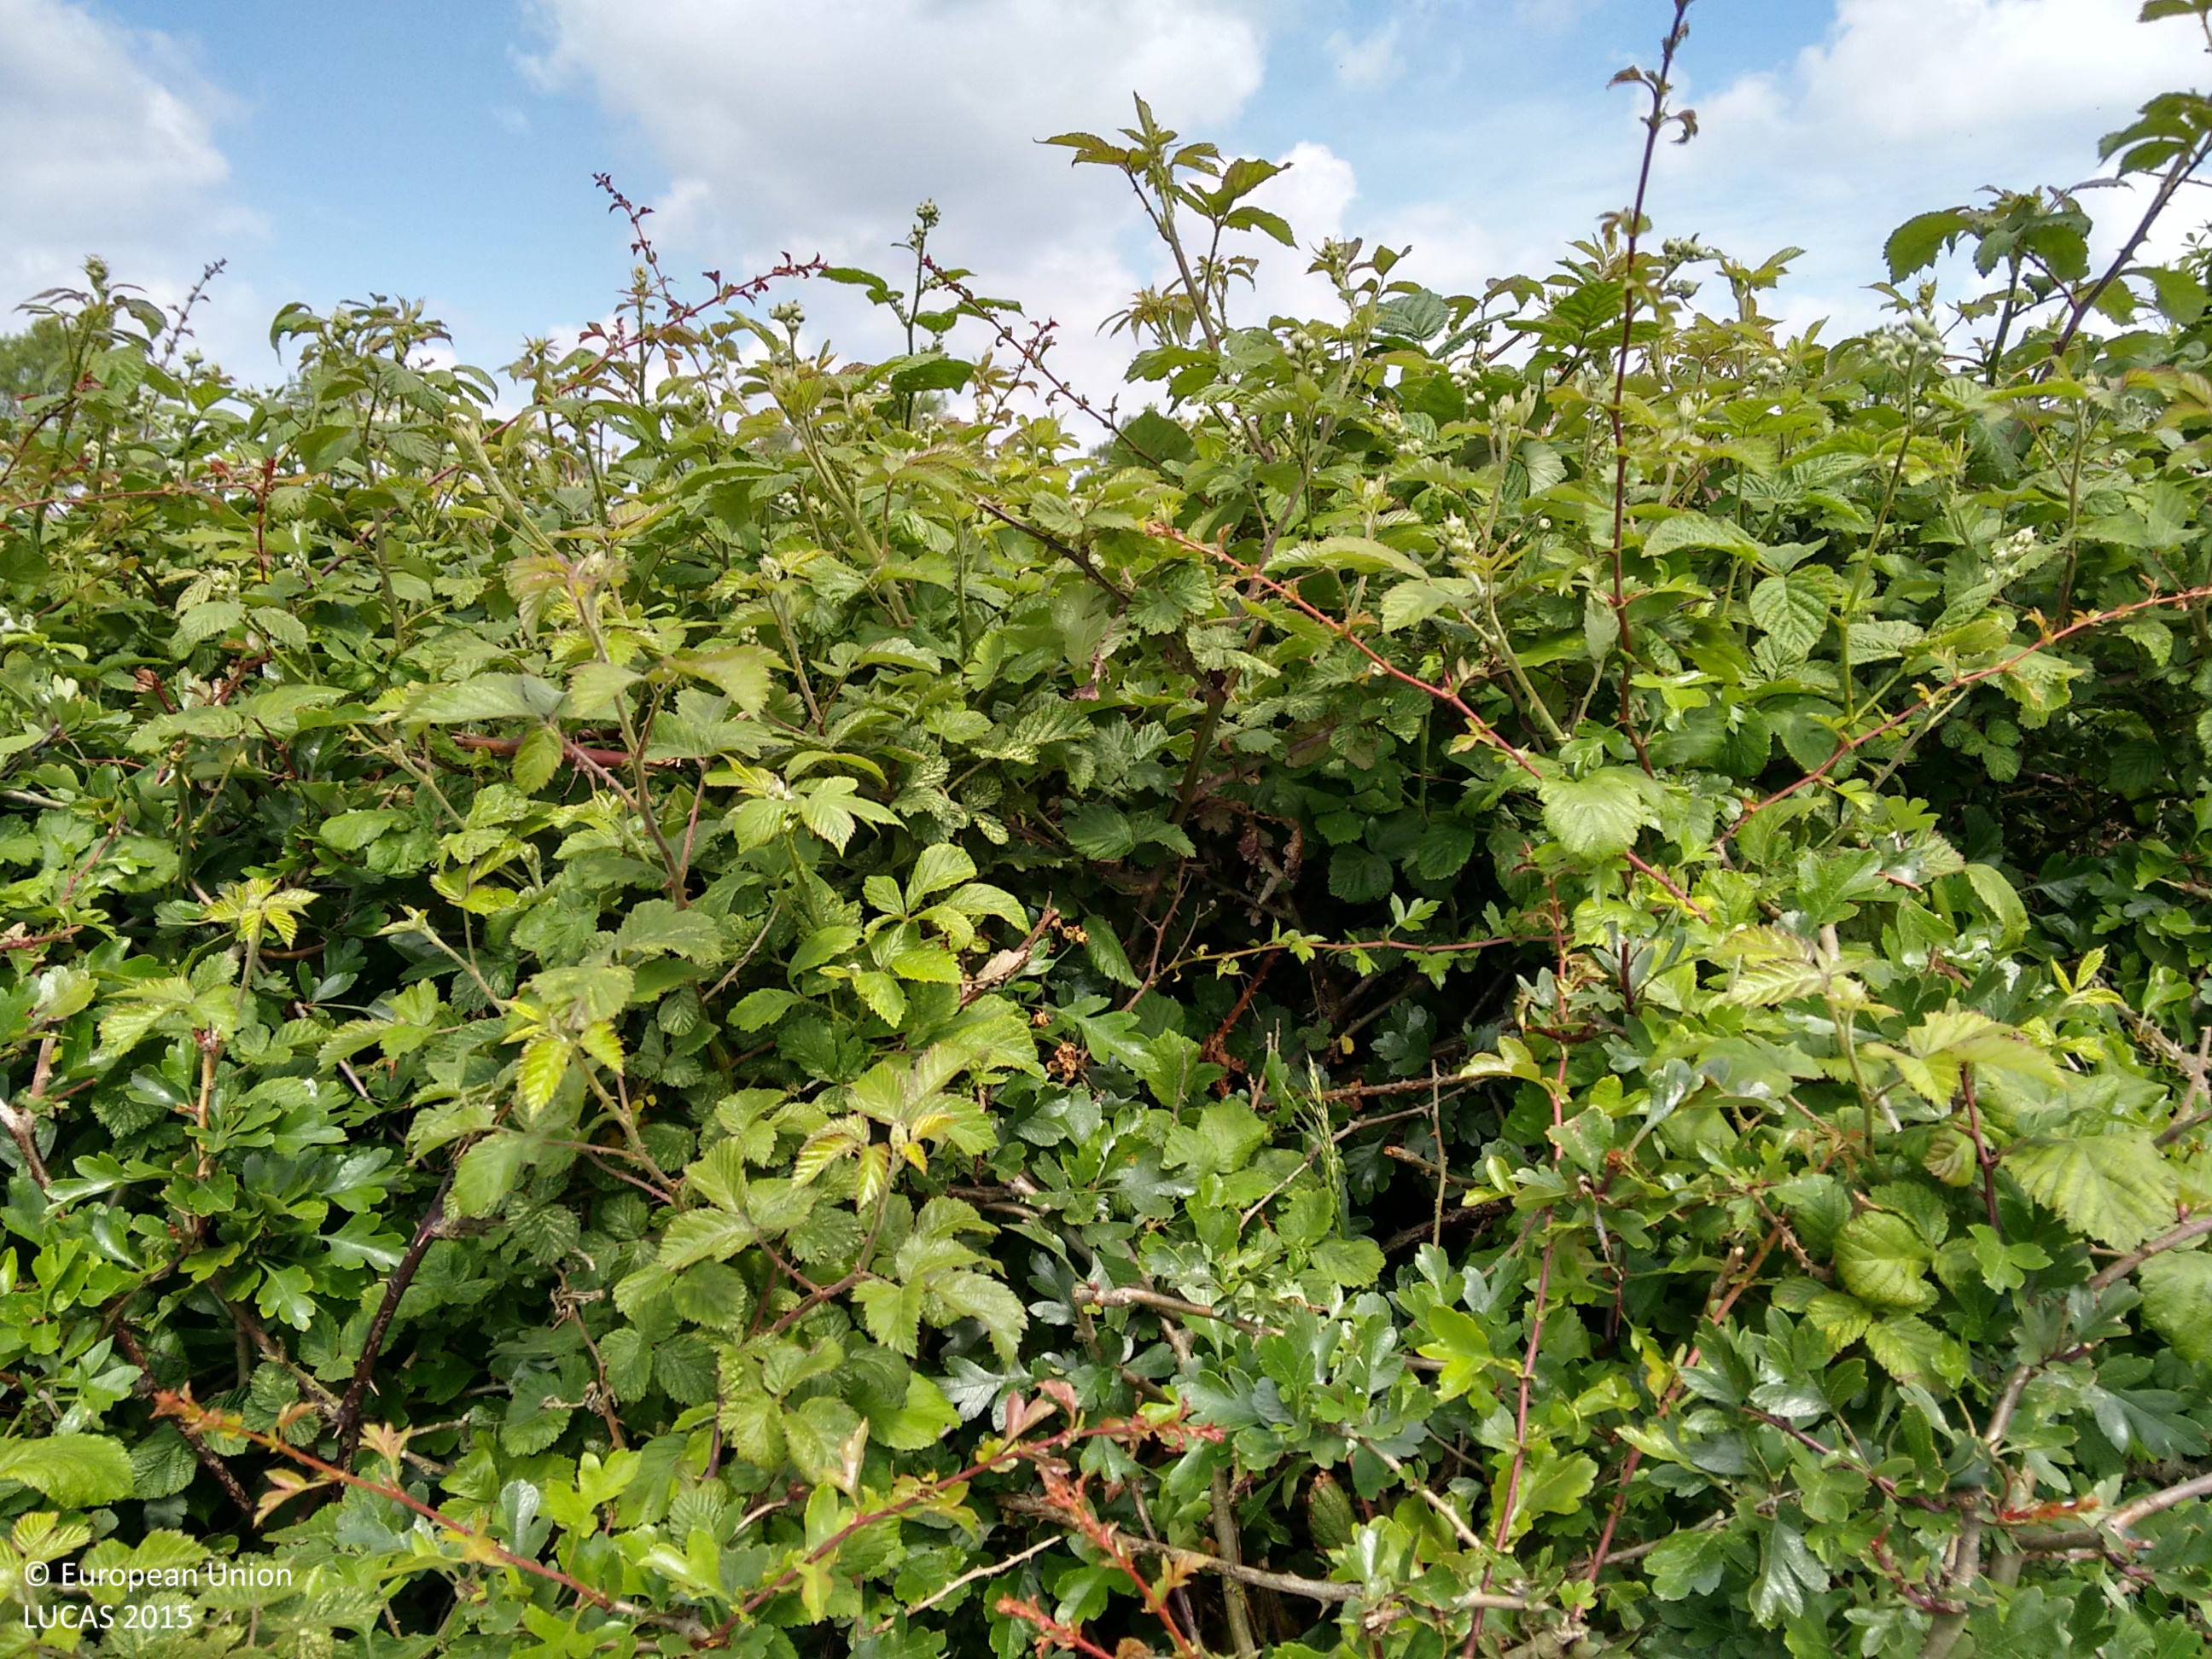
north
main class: Grassland
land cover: Grassland without tree/shrub cover
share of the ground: > 75 %
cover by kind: herbaceous plants 100 %
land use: Agriculture (excluding fallow land and kitchen gardens)
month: June
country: GB
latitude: 53.0252
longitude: -0.6097
